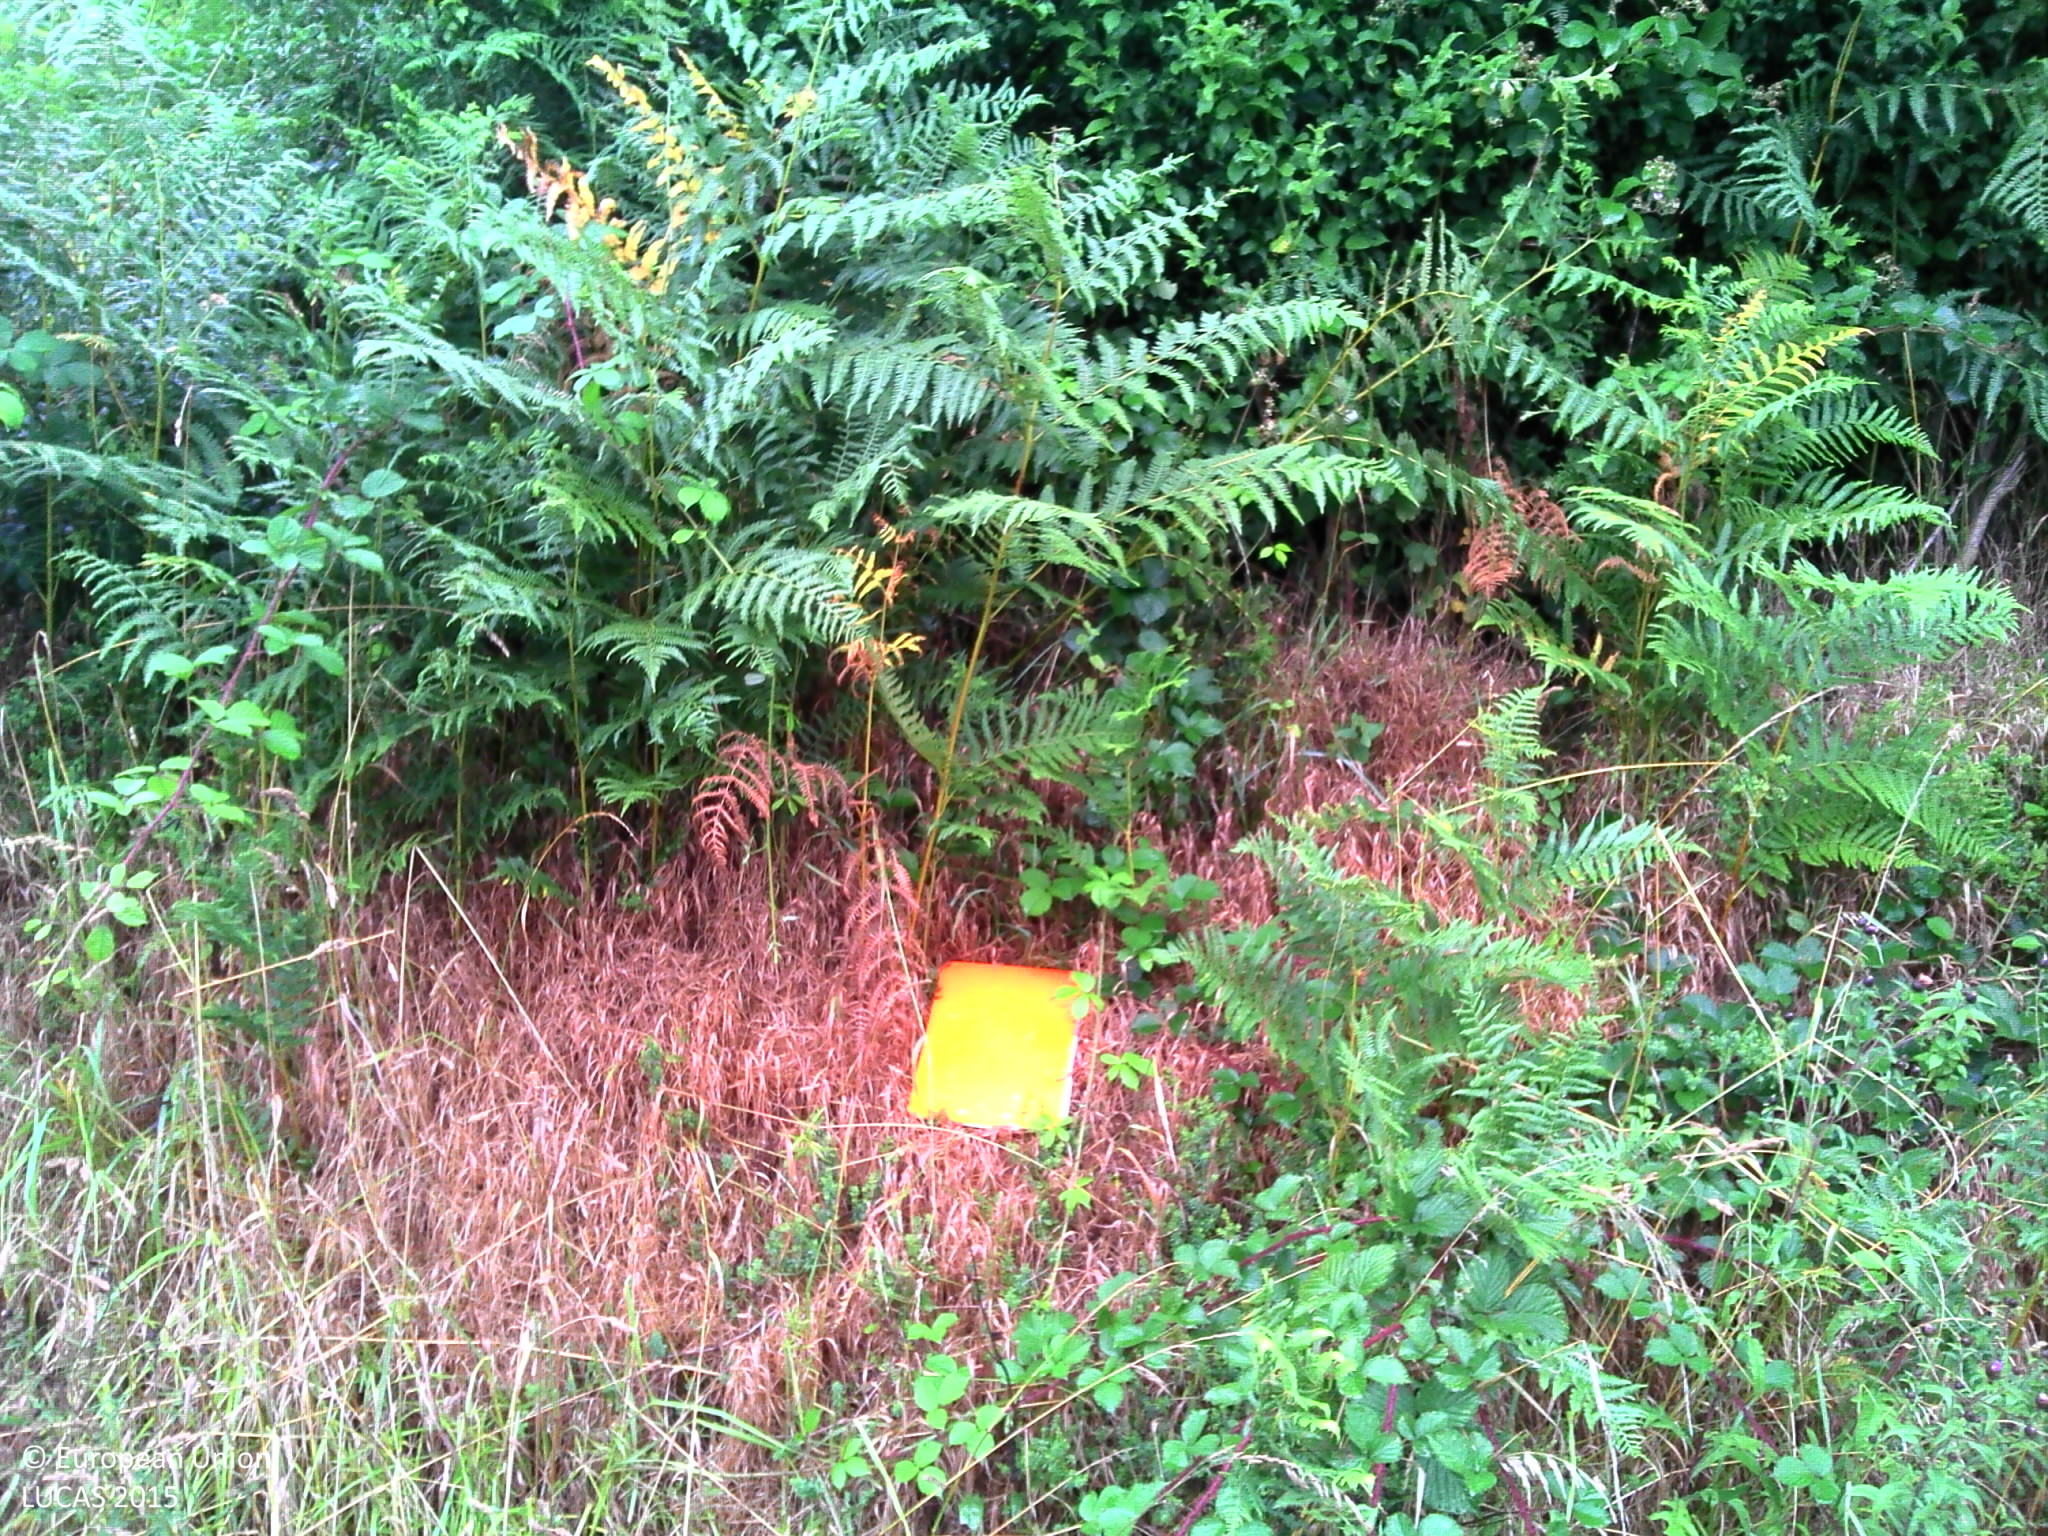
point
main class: Shrubland
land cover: Shrubland with sparse tree cover
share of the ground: > 75 %
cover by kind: shrubs 95 %, broadleaved forest trees 5 %
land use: Forestry
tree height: > 5 m
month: July
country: FR
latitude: 48.2248
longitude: -3.2242
